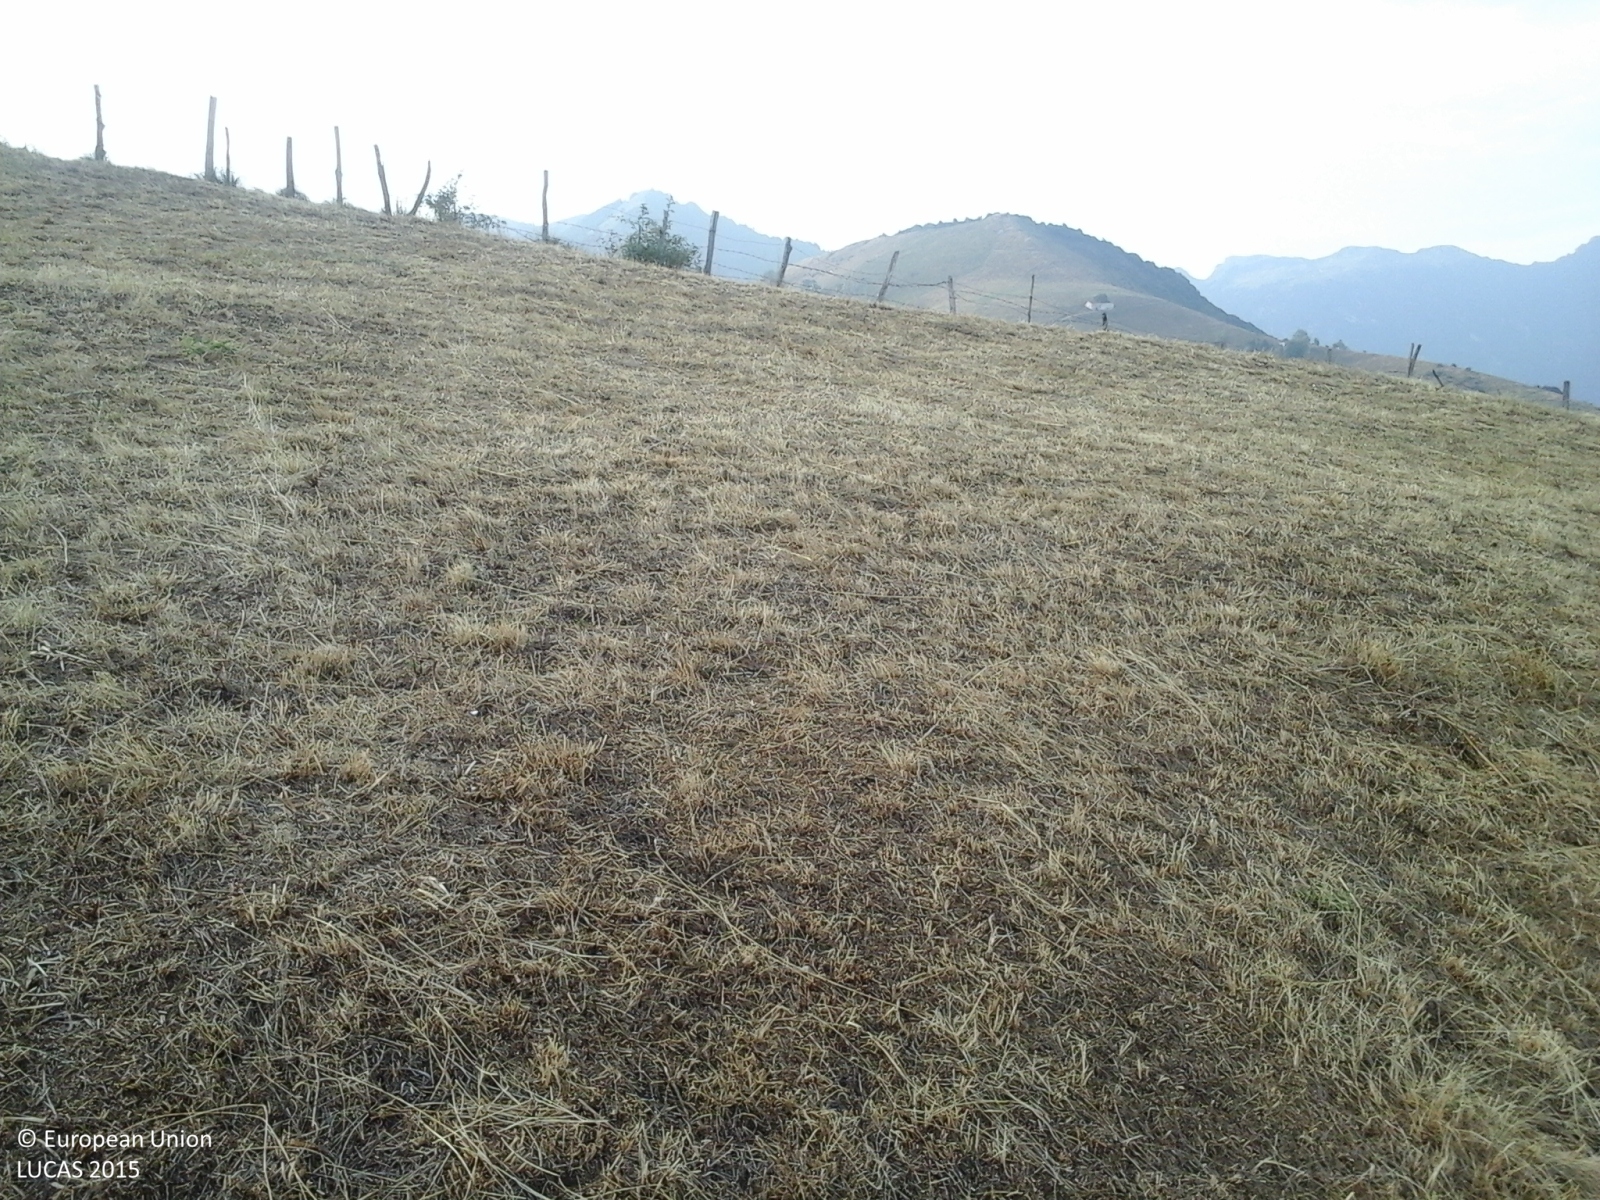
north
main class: Grassland
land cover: Grassland without tree/shrub cover
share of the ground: > 75 %
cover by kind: herbaceous plants 100 %
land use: Agriculture (excluding fallow land and kitchen gardens)
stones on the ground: < 10 %
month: July
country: IT
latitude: 45.6241
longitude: 11.1653
